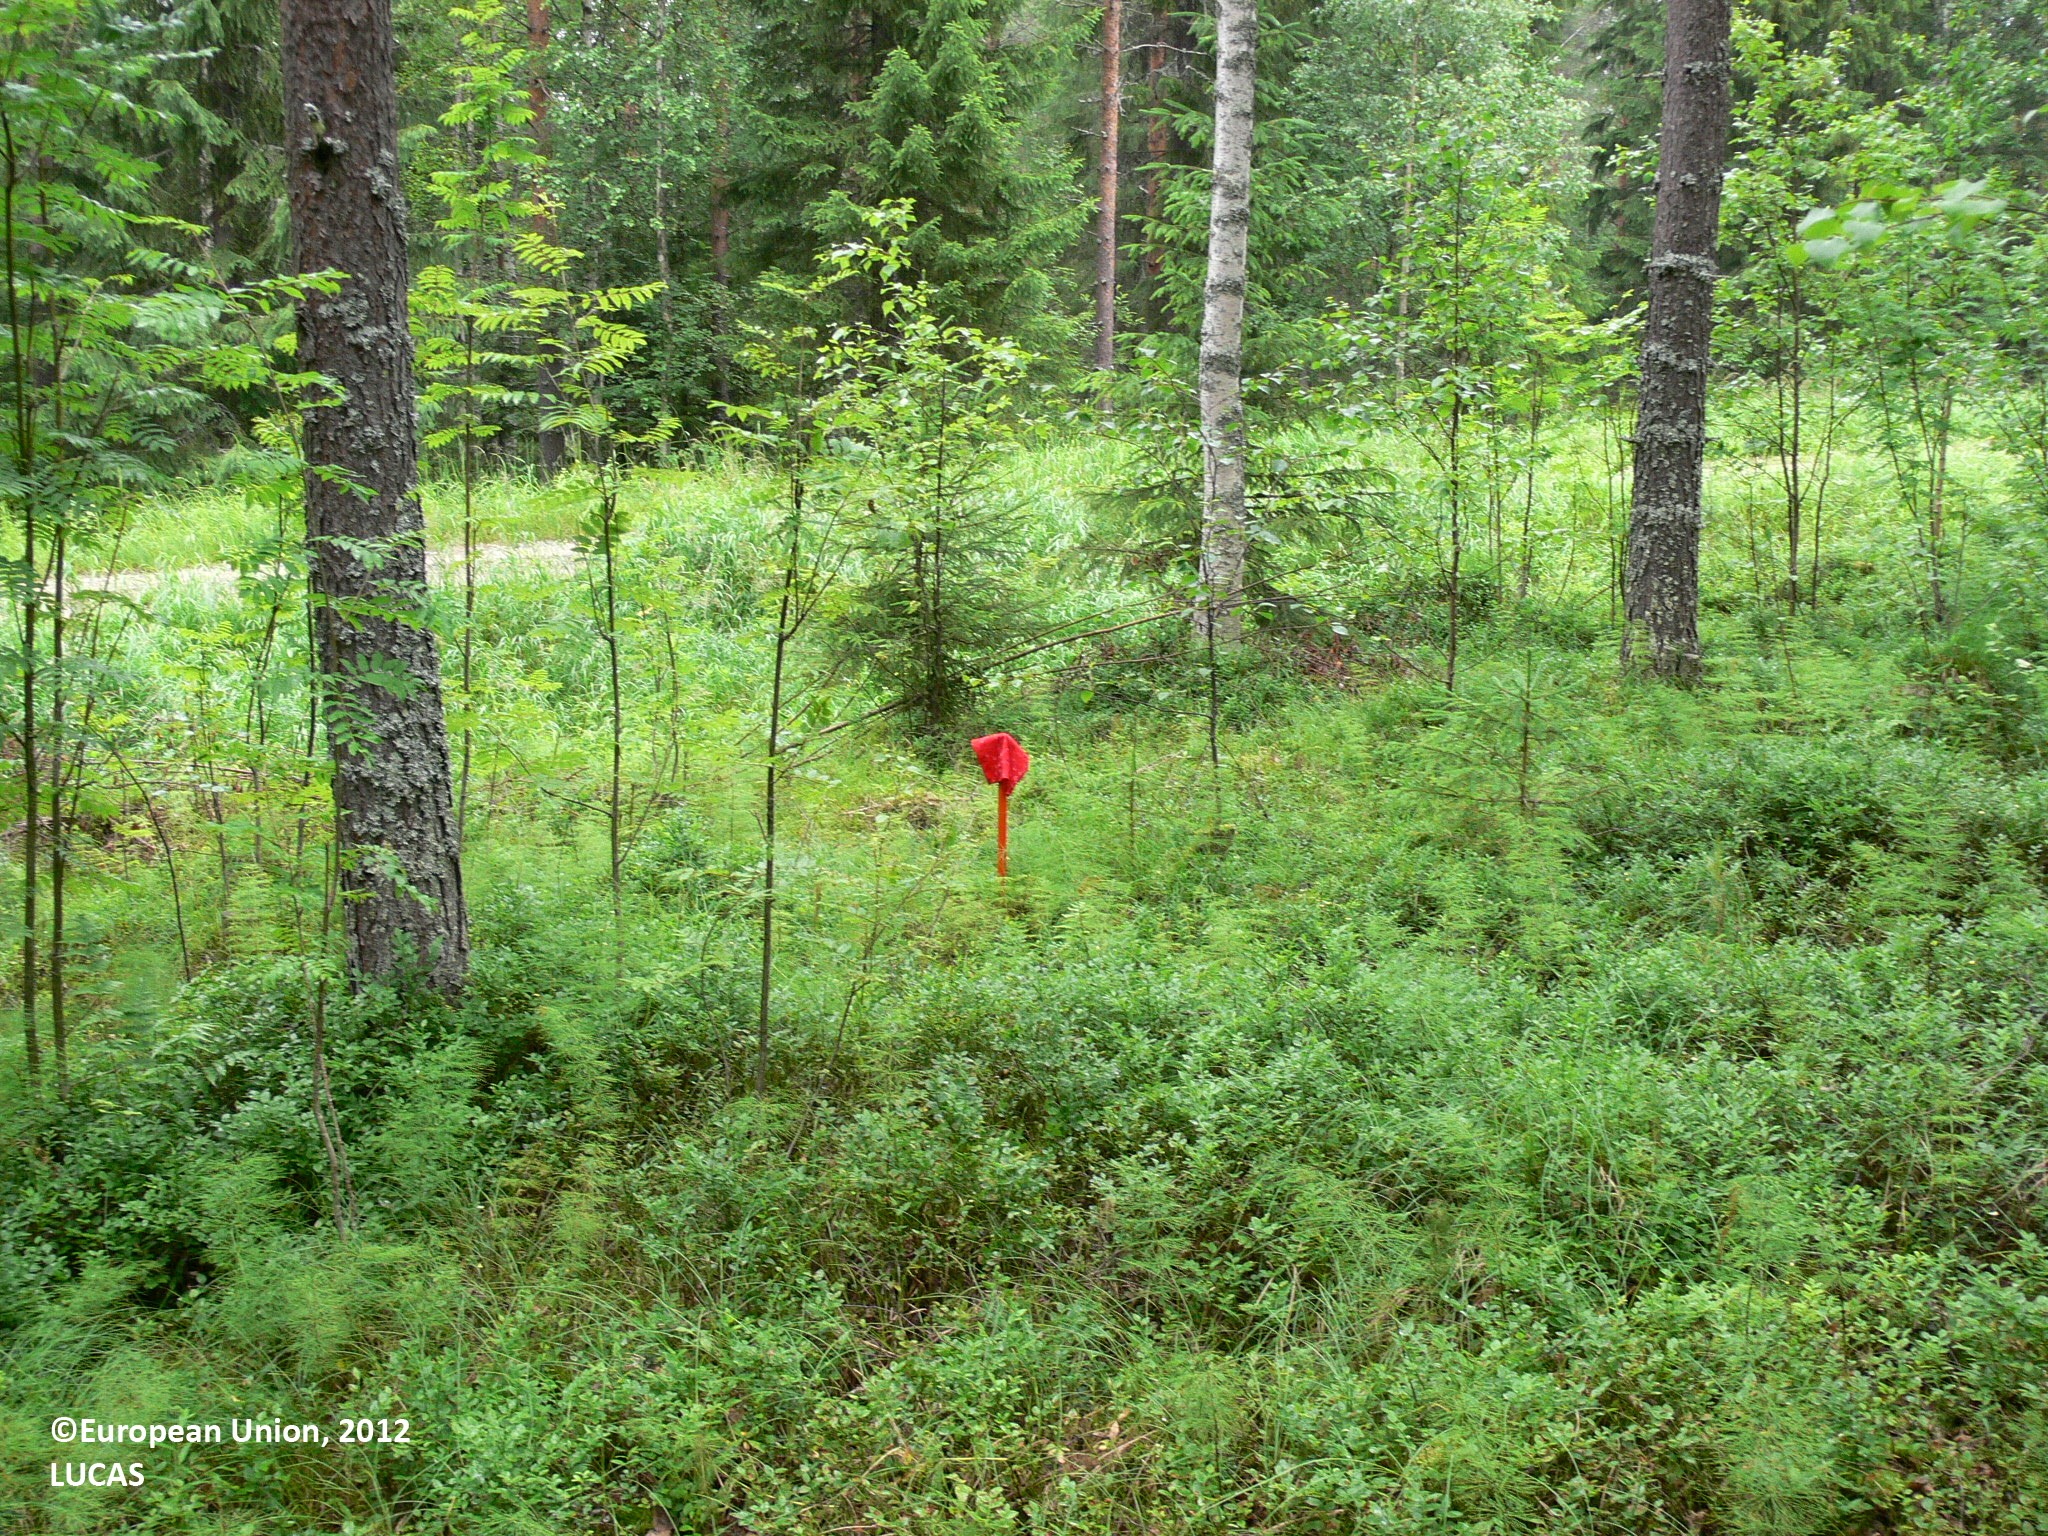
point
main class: Woodland
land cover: Other mixed woodland
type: boreal forest
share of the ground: > 75 %
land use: Forestry
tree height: > 5 m
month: July
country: FI
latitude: 63.2301
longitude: 30.8464
